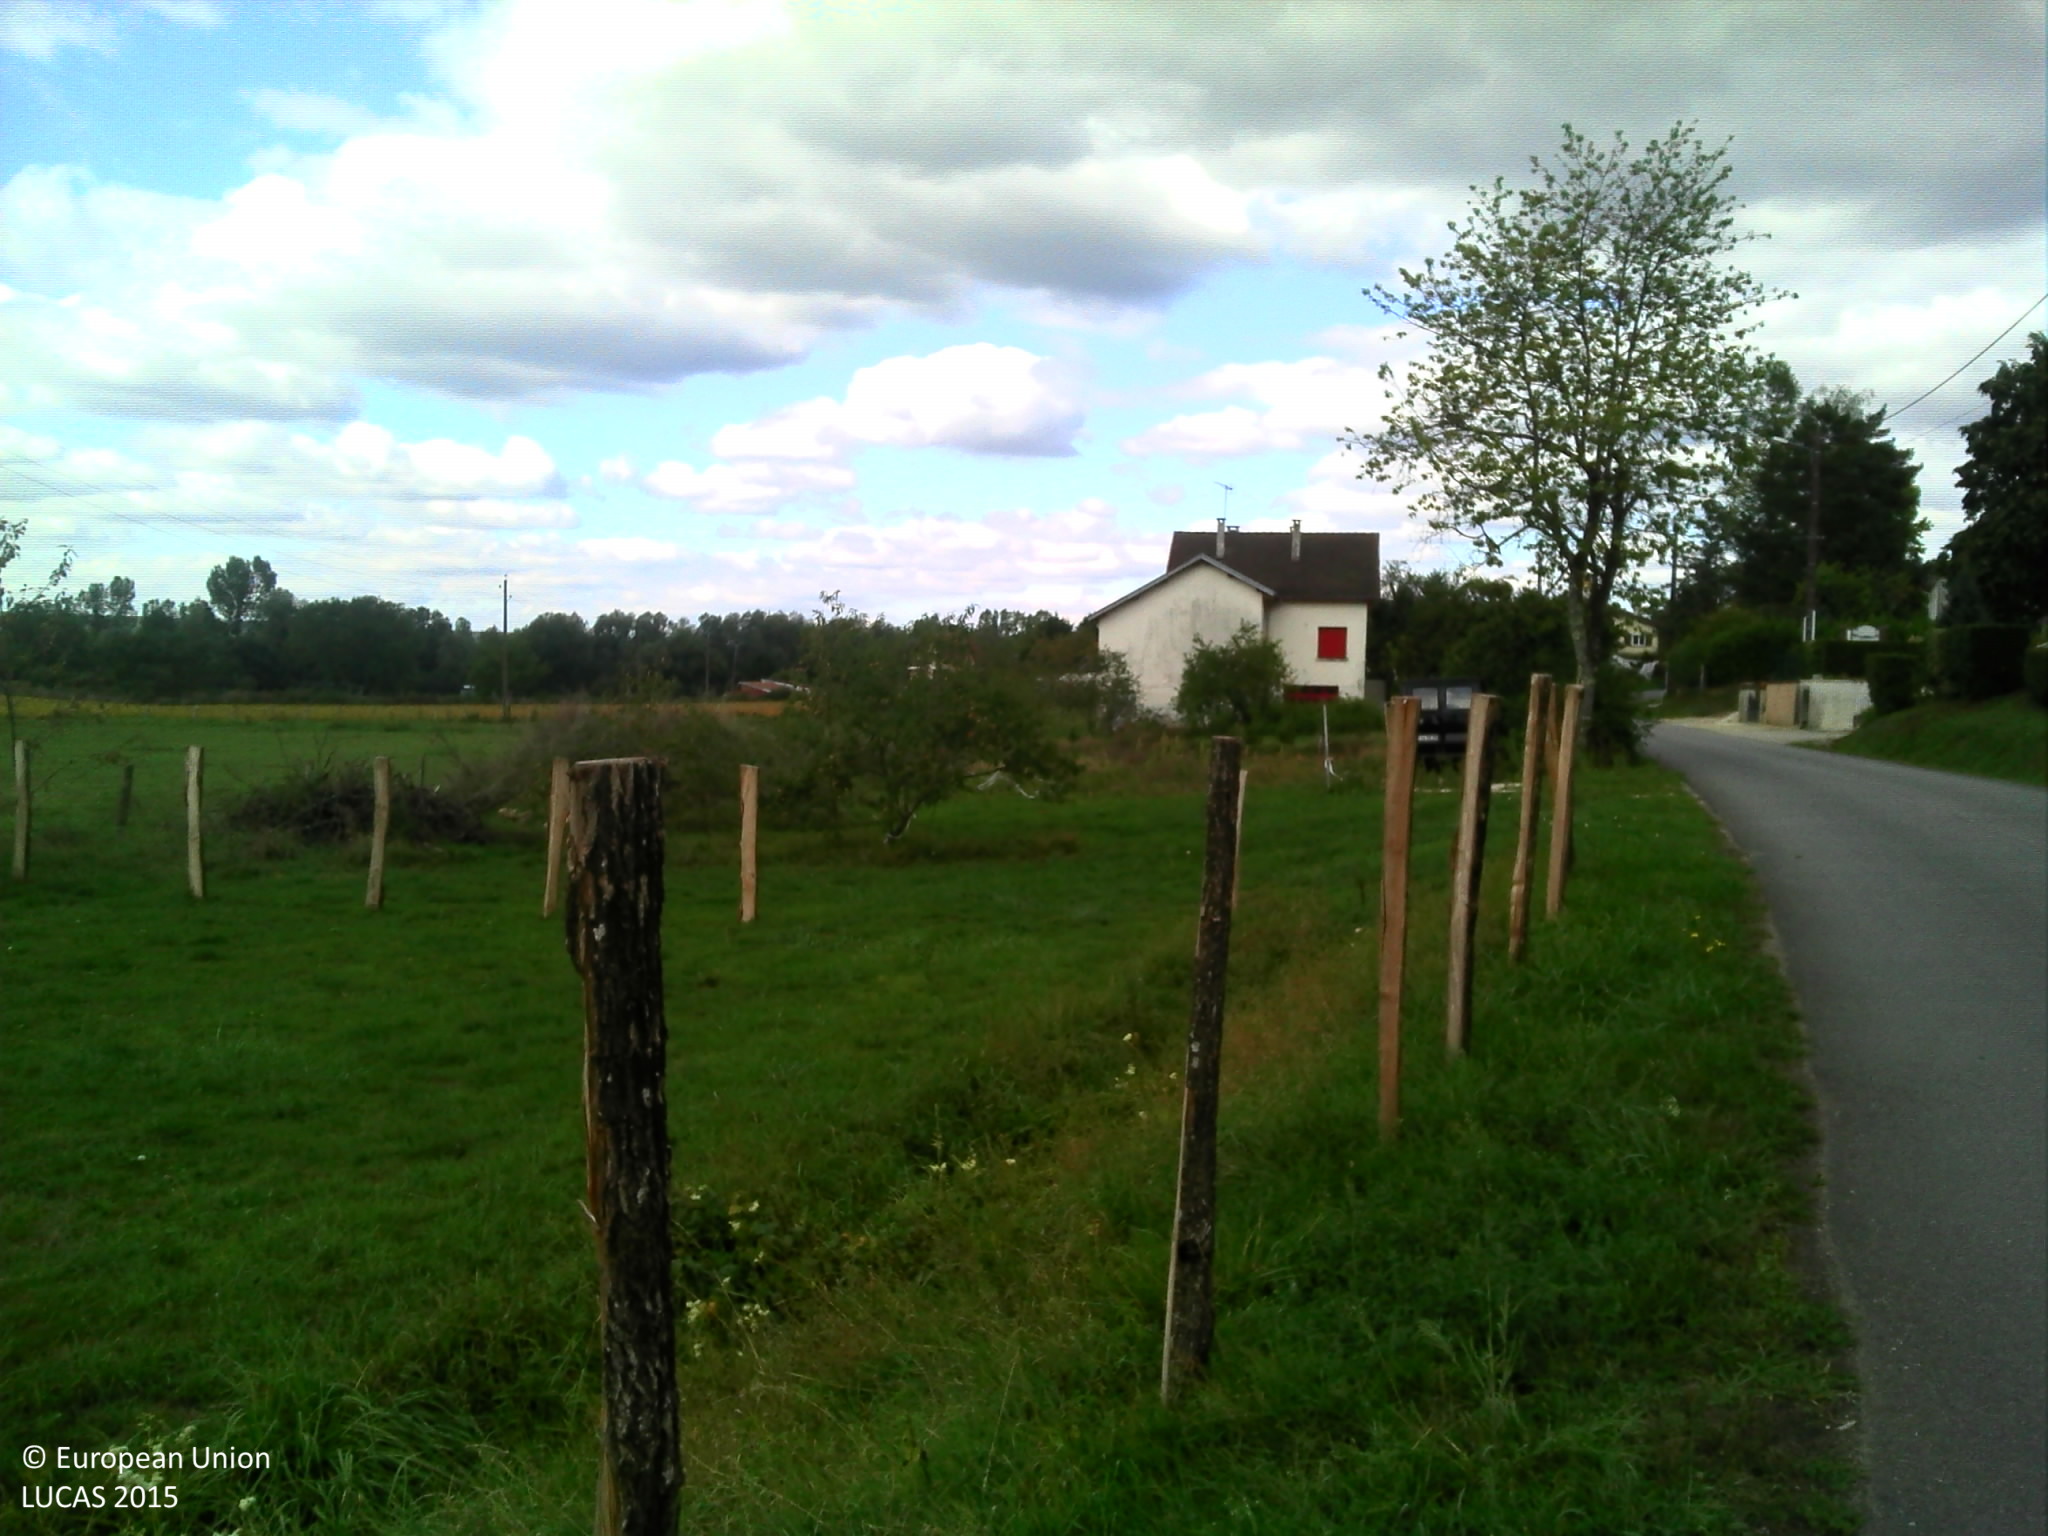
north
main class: Grassland
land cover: Grassland without tree/shrub cover
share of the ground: > 75 %
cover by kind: herbaceous plants 100 %
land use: Residential
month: September
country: FR
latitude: 47.3824
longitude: 6.1736
